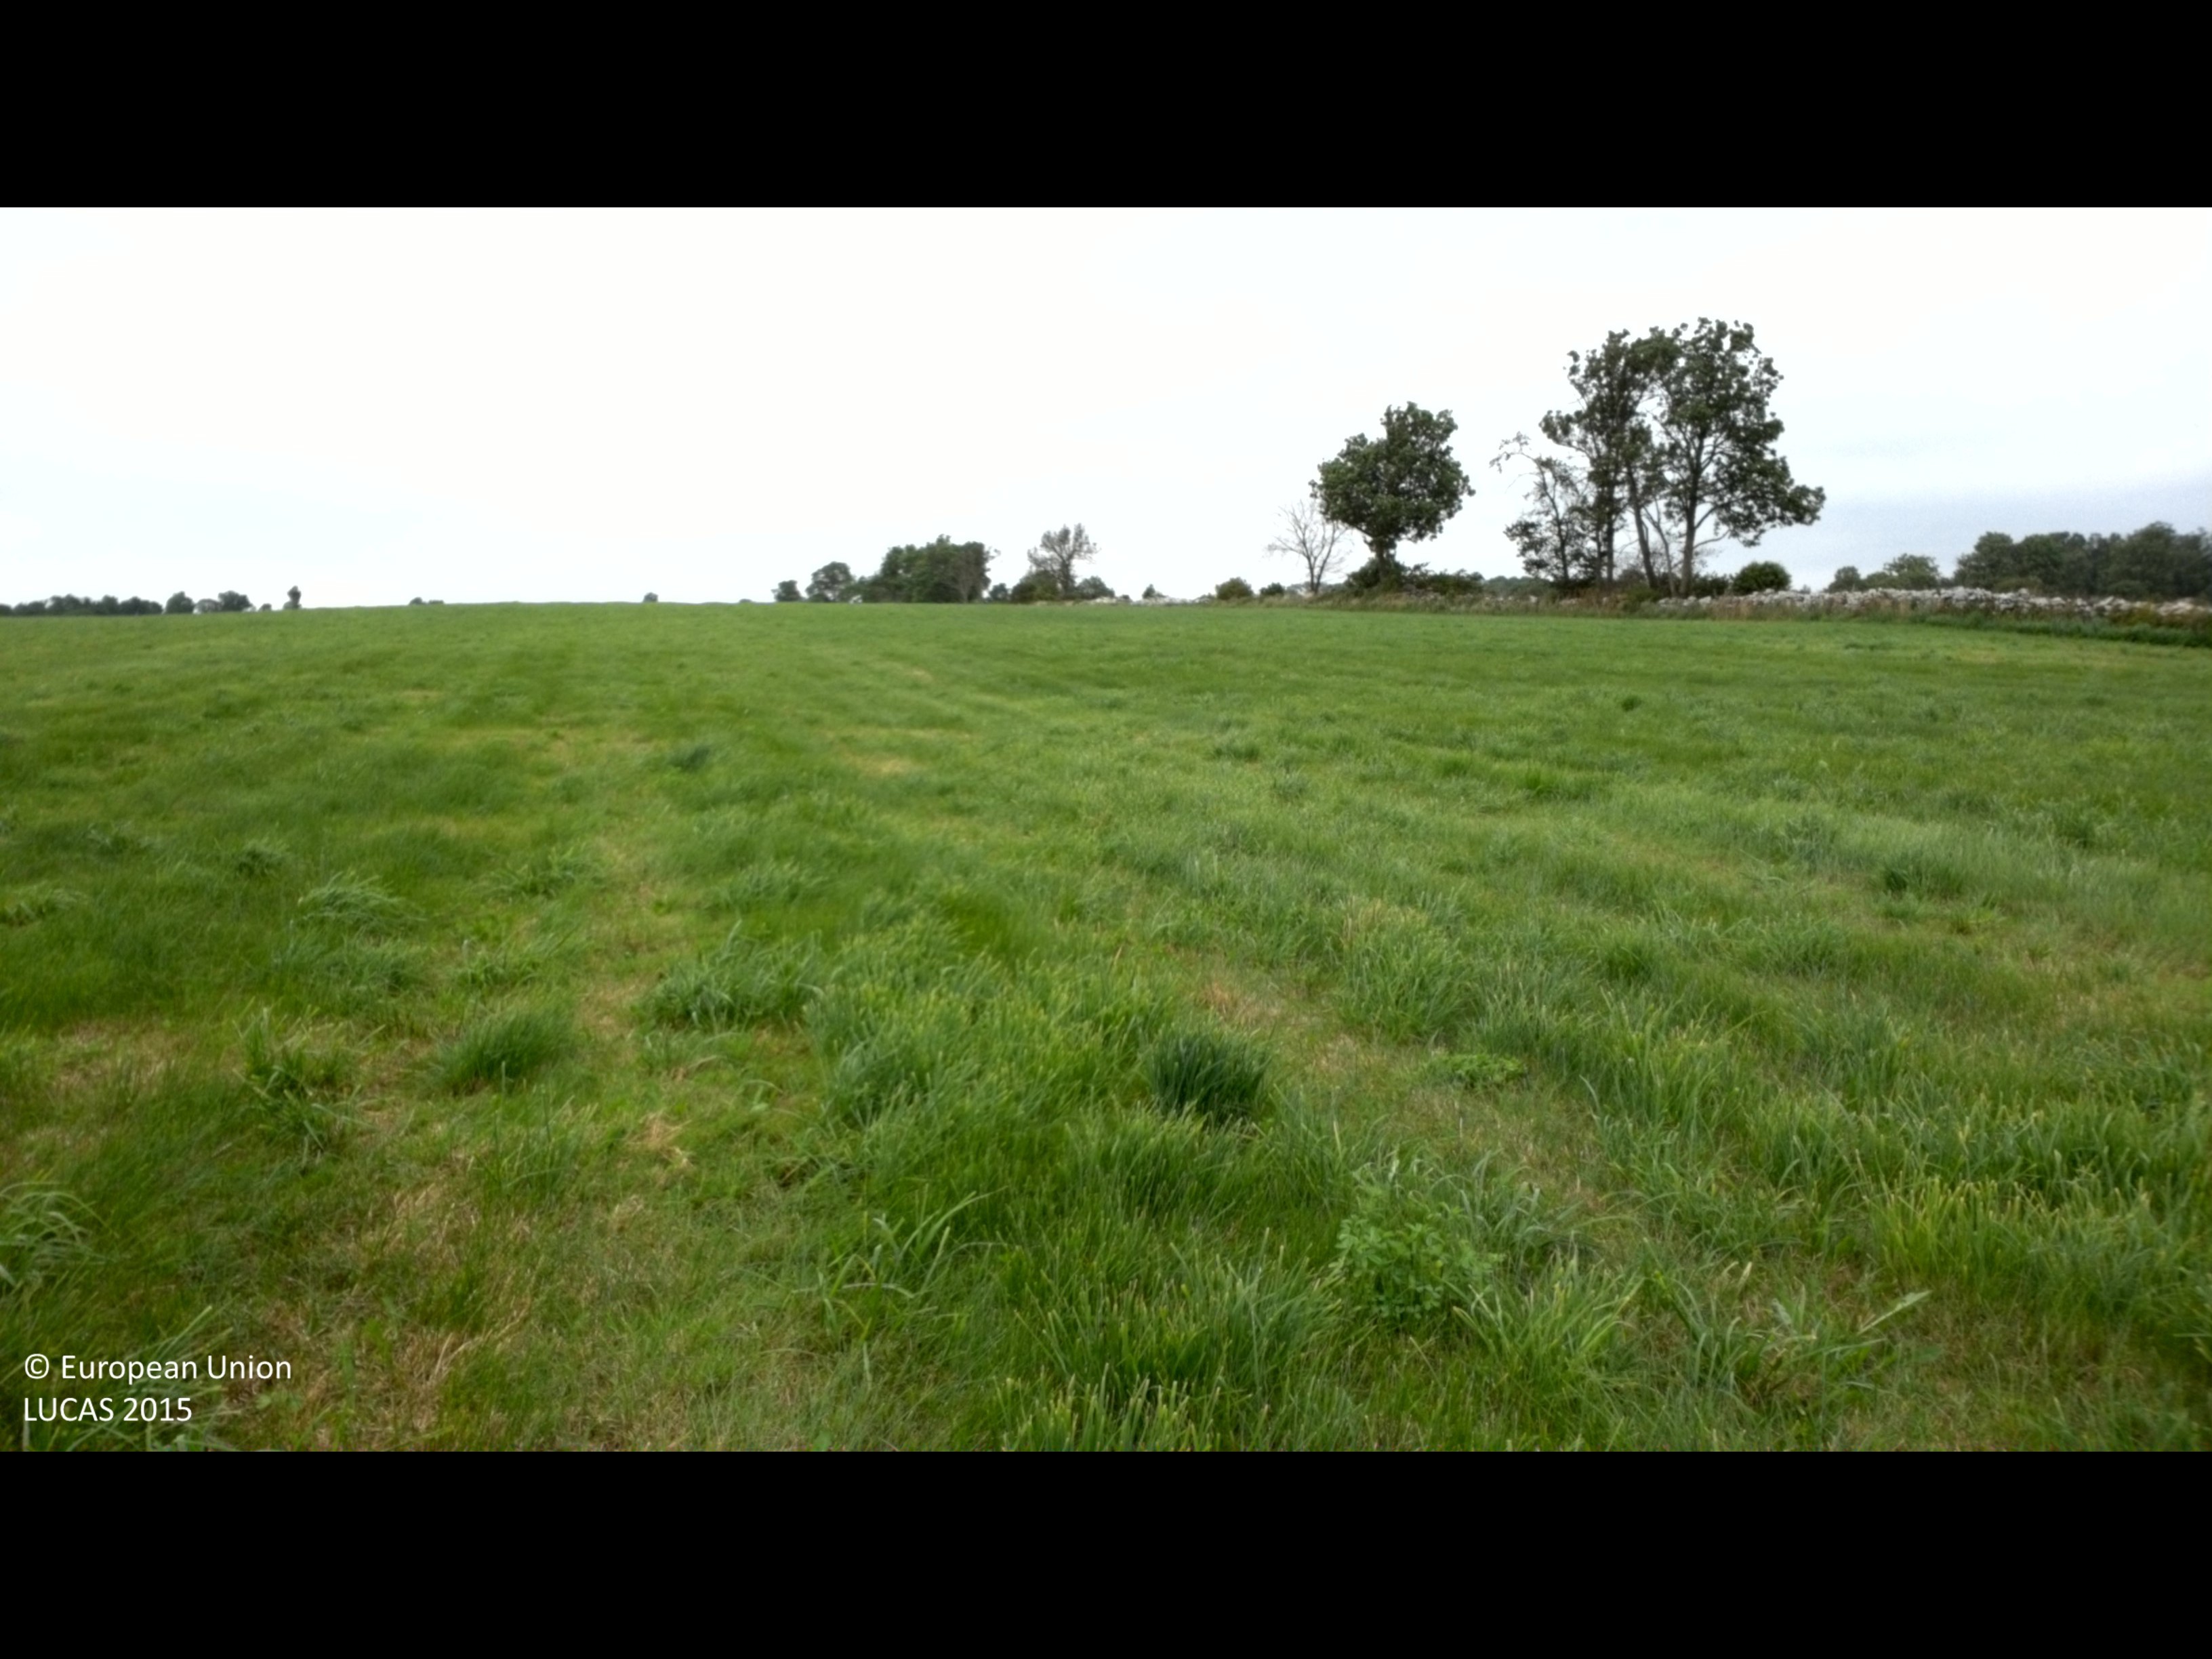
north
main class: Cropland
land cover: Temporary grasslands
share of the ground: > 75 %
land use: Agriculture (excluding fallow land and kitchen gardens)
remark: Harvested field
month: July
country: SE
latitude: 56.8101
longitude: 16.6351
